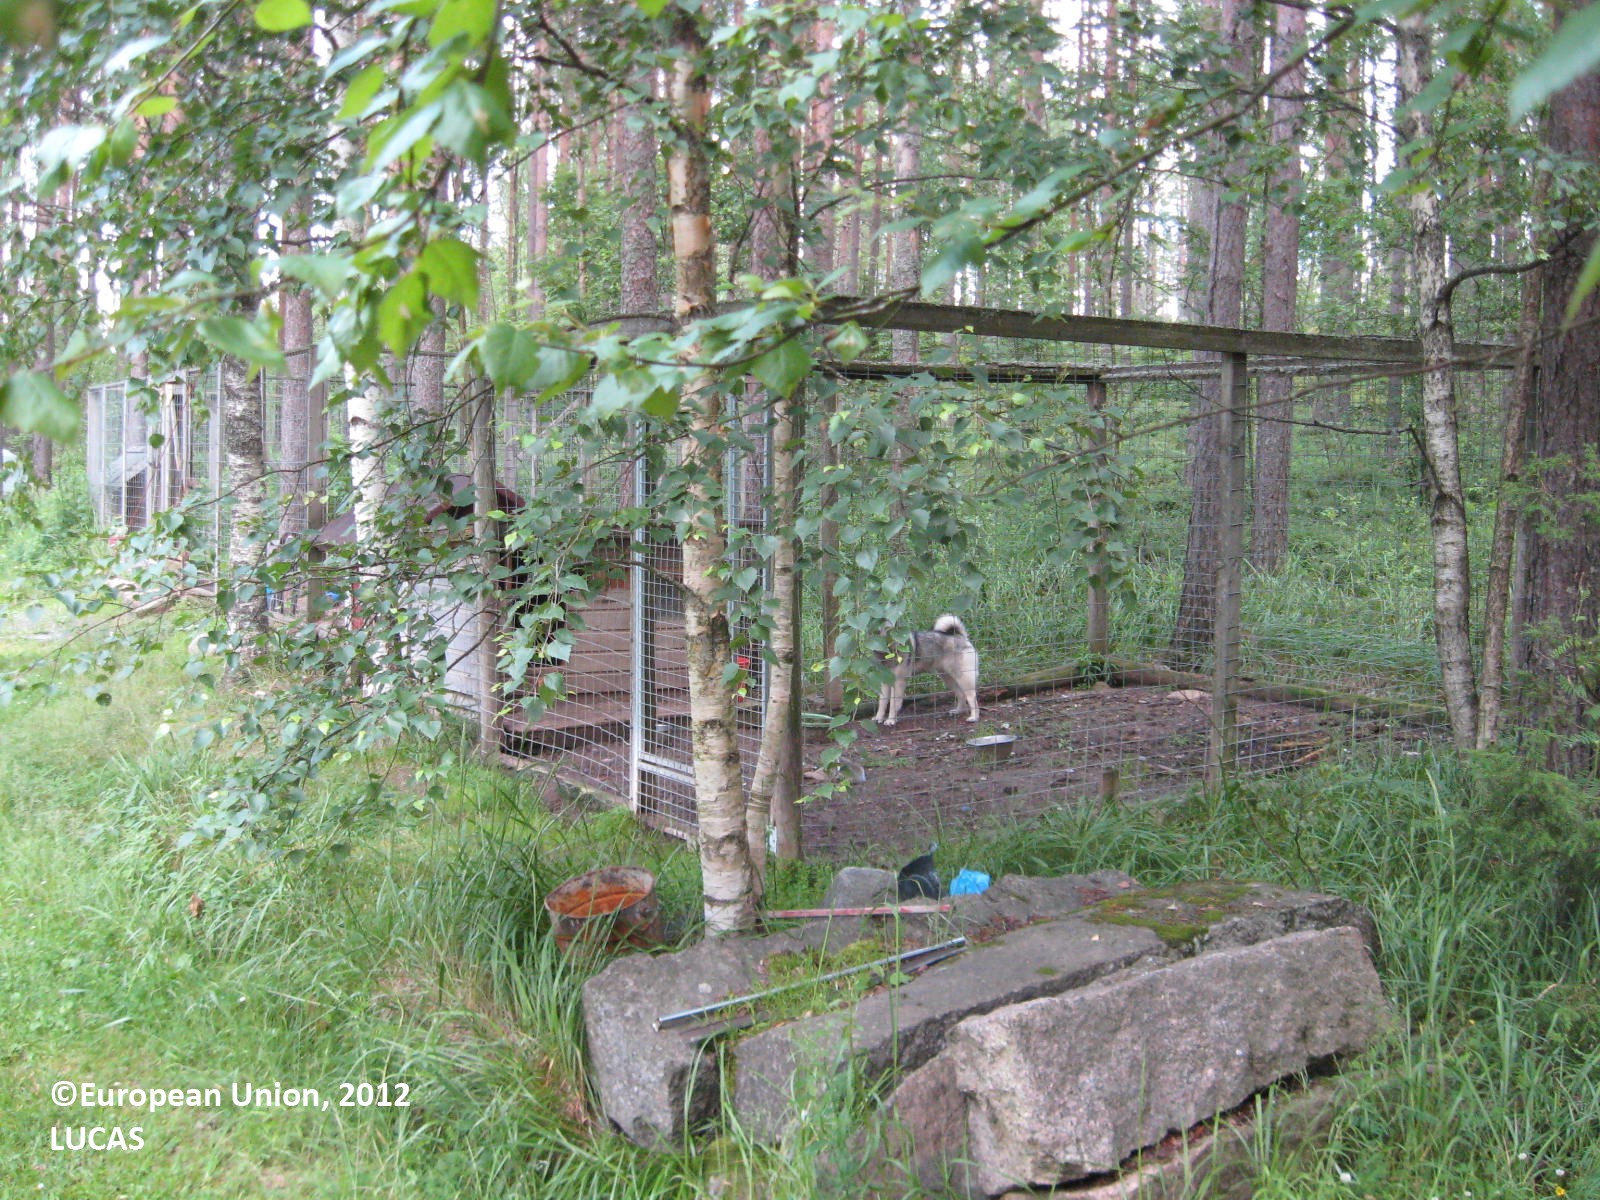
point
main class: Woodland
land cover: Pine dominated coniferous woodland
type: boreal forest
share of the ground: > 75 %
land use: Forestry
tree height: > 5 m
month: July
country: FI
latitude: 62.3104
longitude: 22.6951
